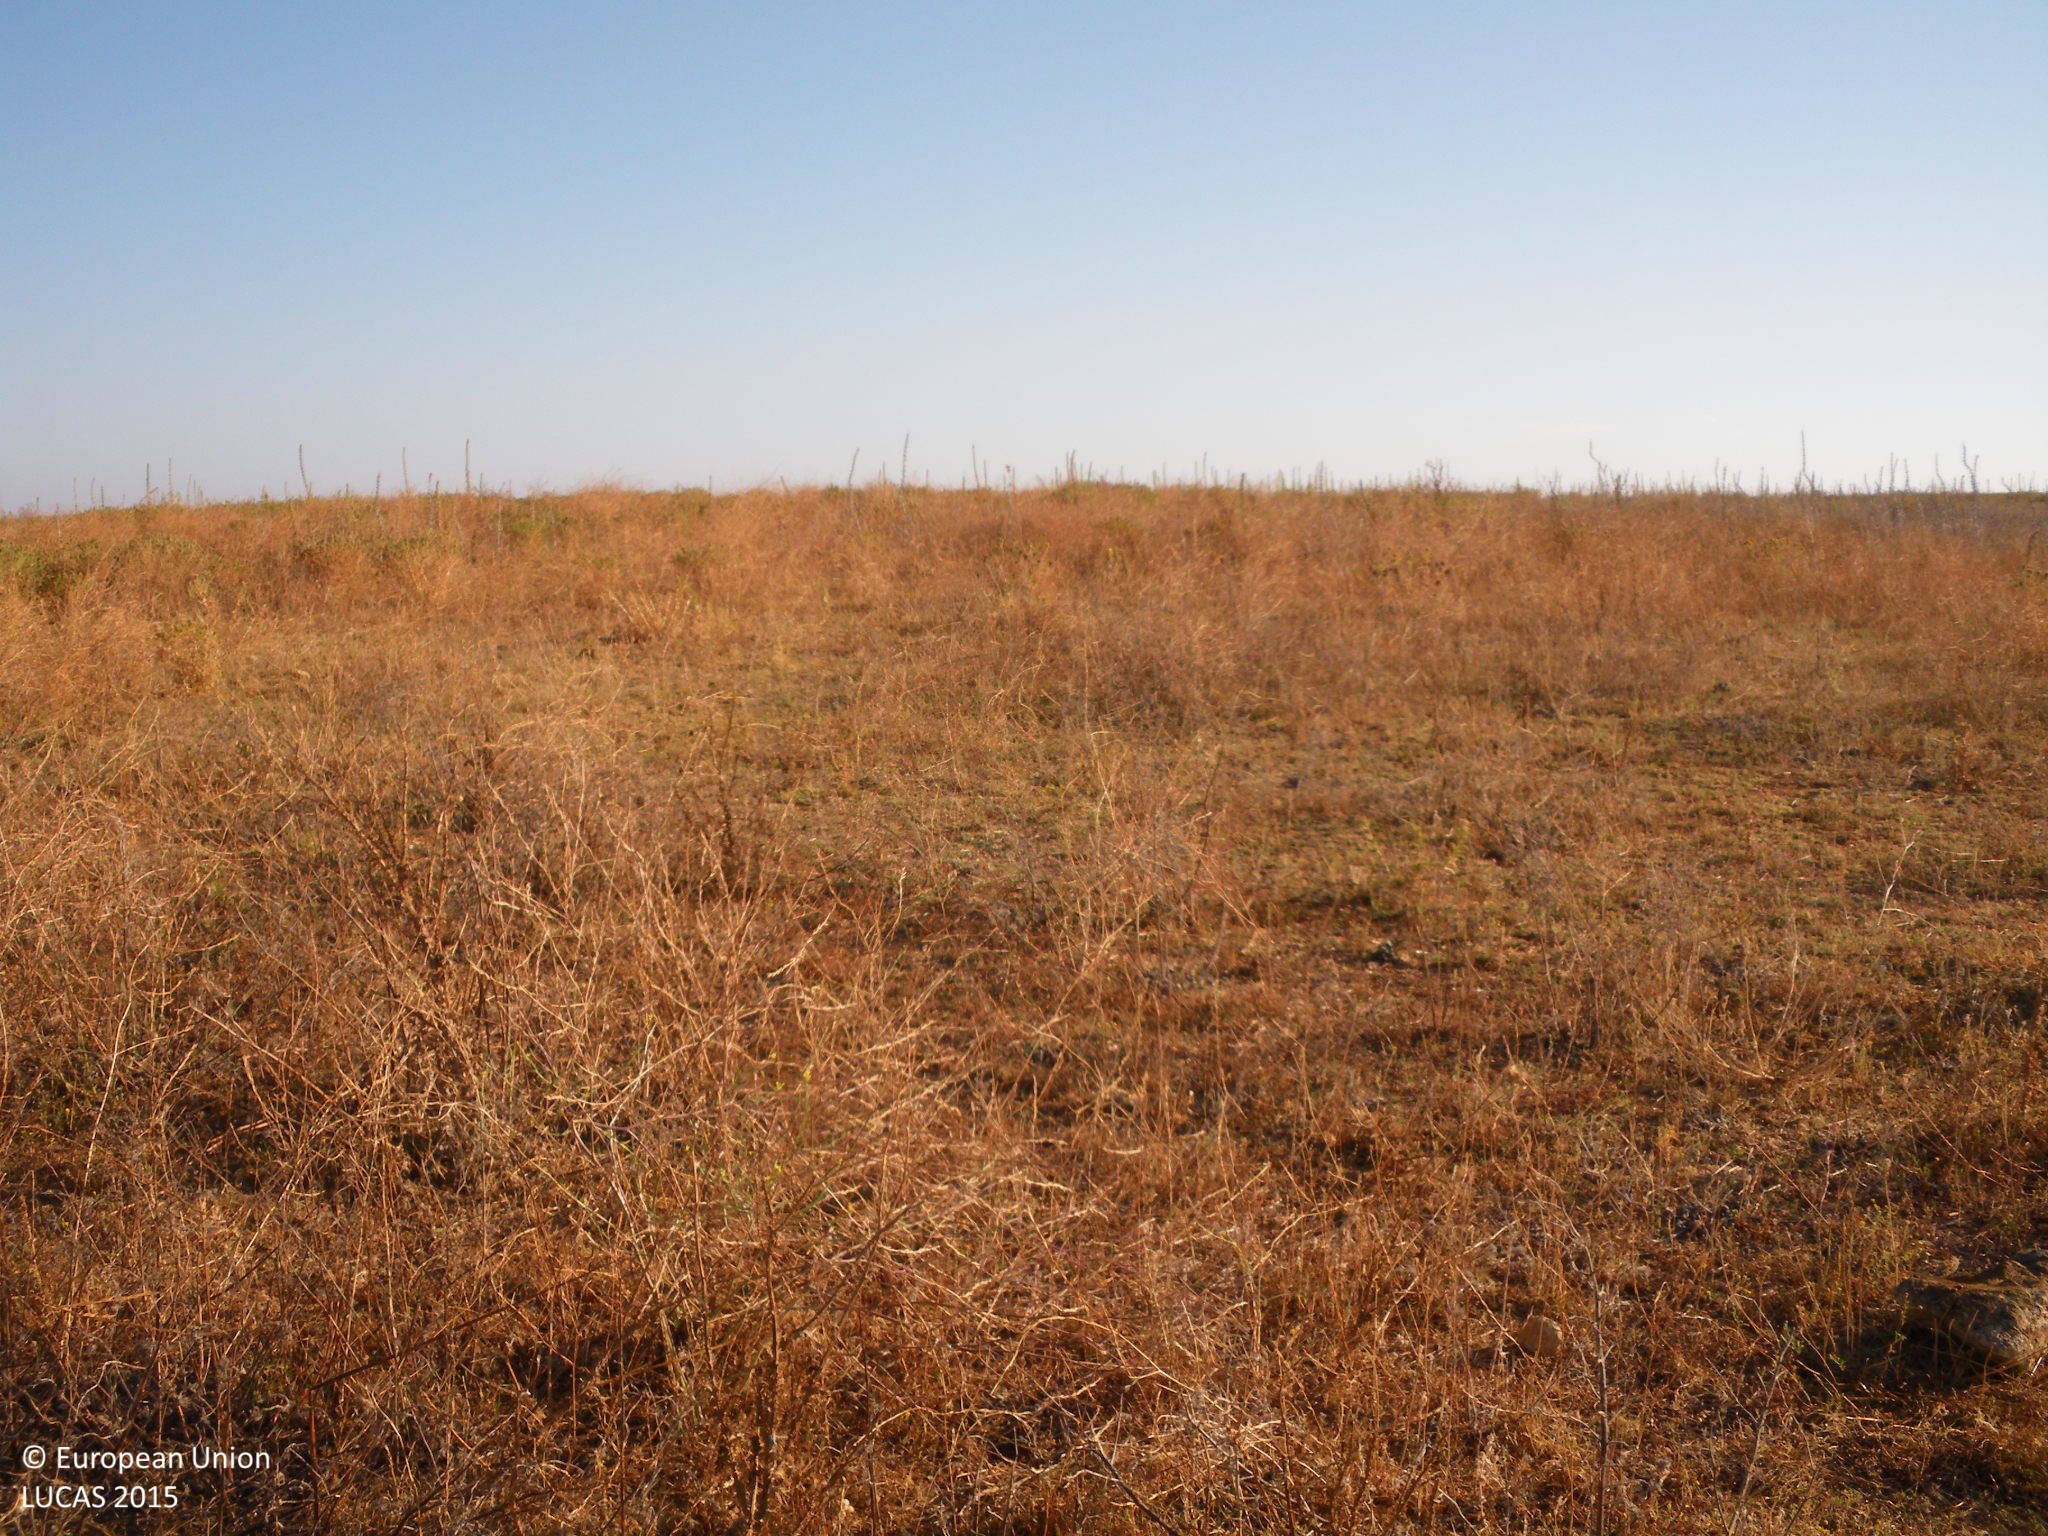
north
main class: Grassland
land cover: Grassland without tree/shrub cover
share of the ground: > 75 %
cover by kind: herbaceous plants 95 %, unconsolidated bare surface 5 %
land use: Agriculture (excluding fallow land and kitchen gardens)
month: June
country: ES
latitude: 36.8296
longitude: -5.7622
